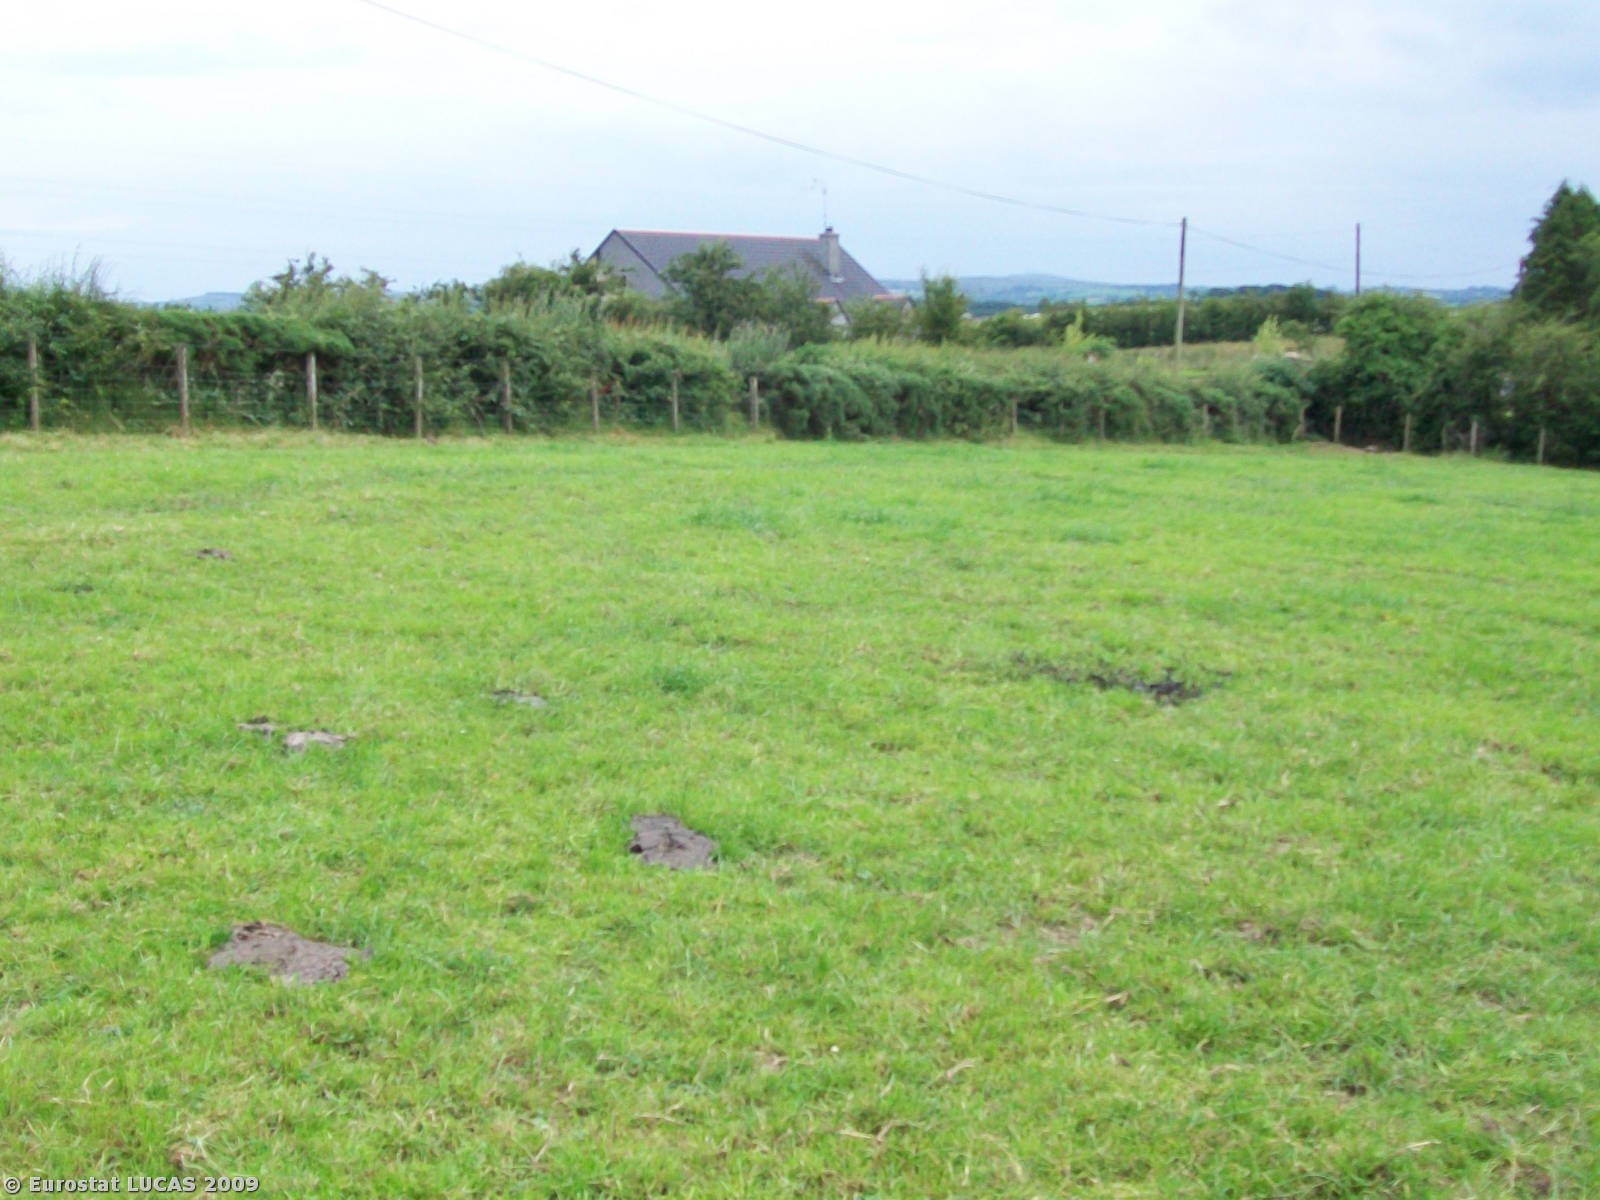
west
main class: Grassland
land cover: Grassland without tree/shrub cover
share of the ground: > 75 %
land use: Agriculture (excluding fallow land and kitchen gardens)
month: June
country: GB
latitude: 54.5220
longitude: -7.4100
